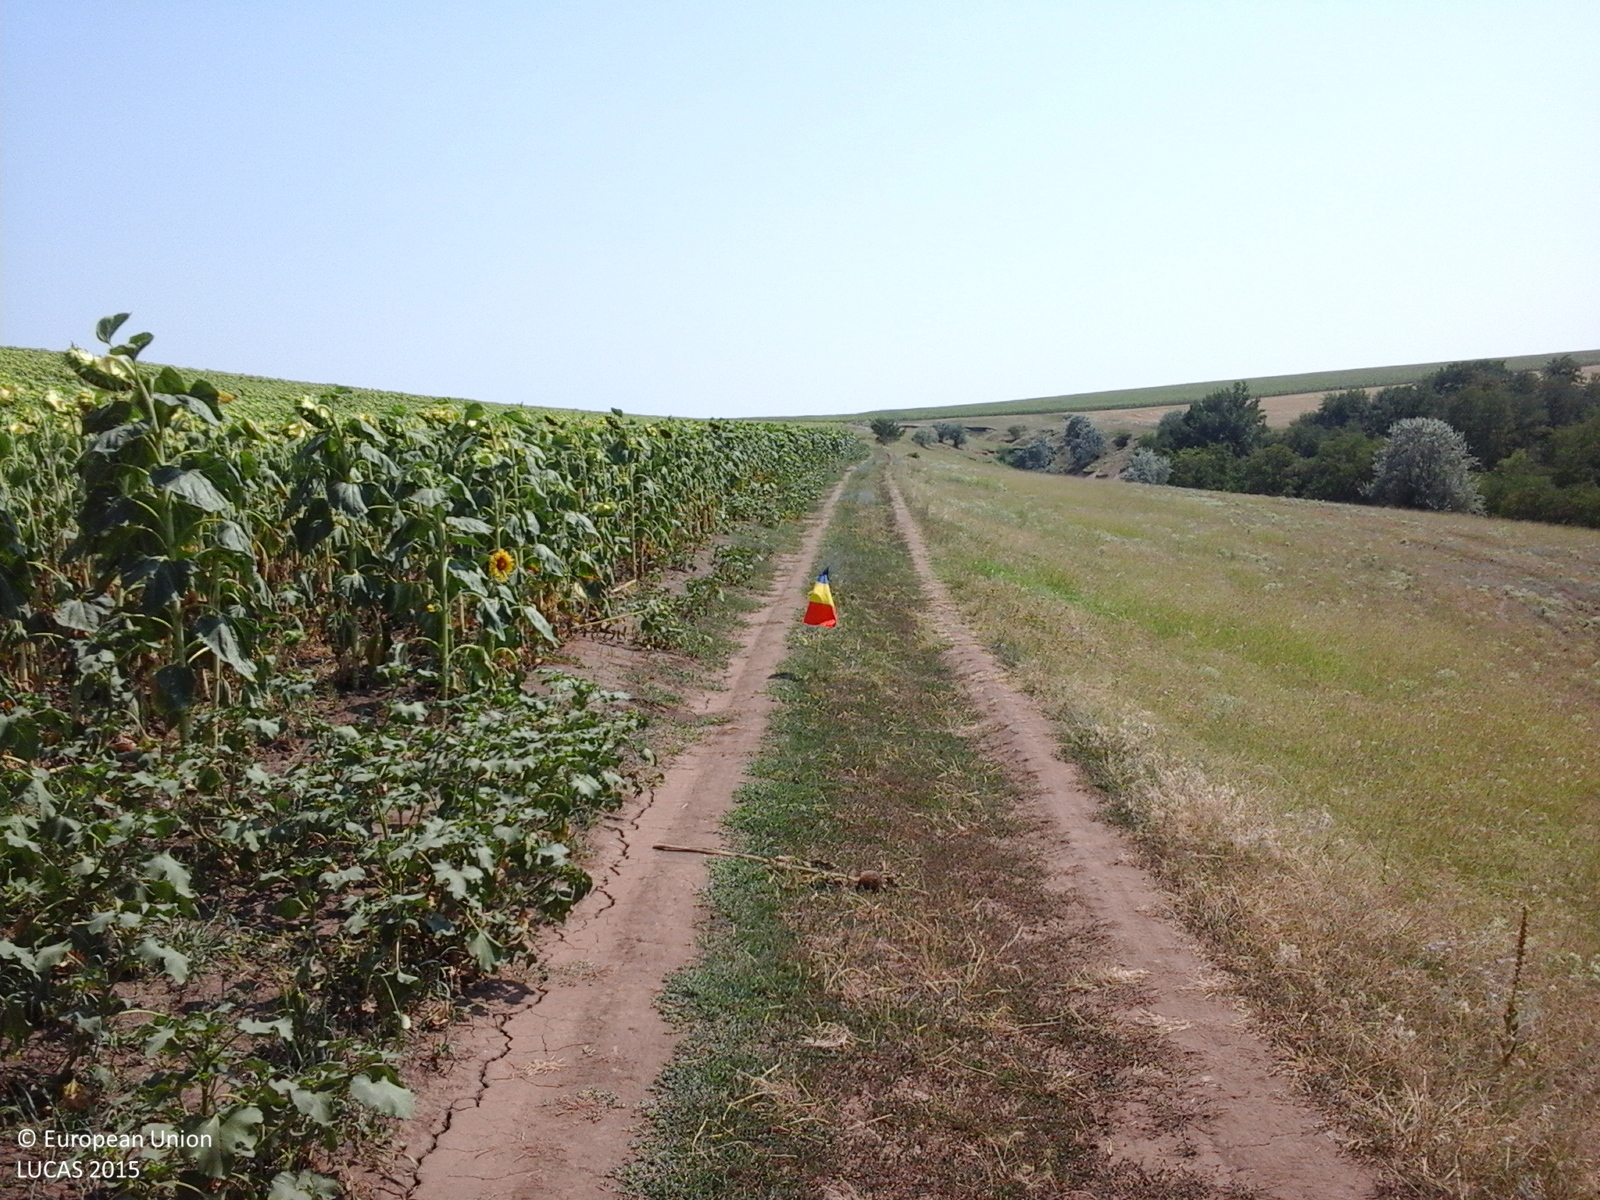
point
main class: Cropland
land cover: Sunflower
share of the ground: > 75 %
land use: Agriculture (excluding fallow land and kitchen gardens)
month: July
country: RO
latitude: 45.7001
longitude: 27.9574
